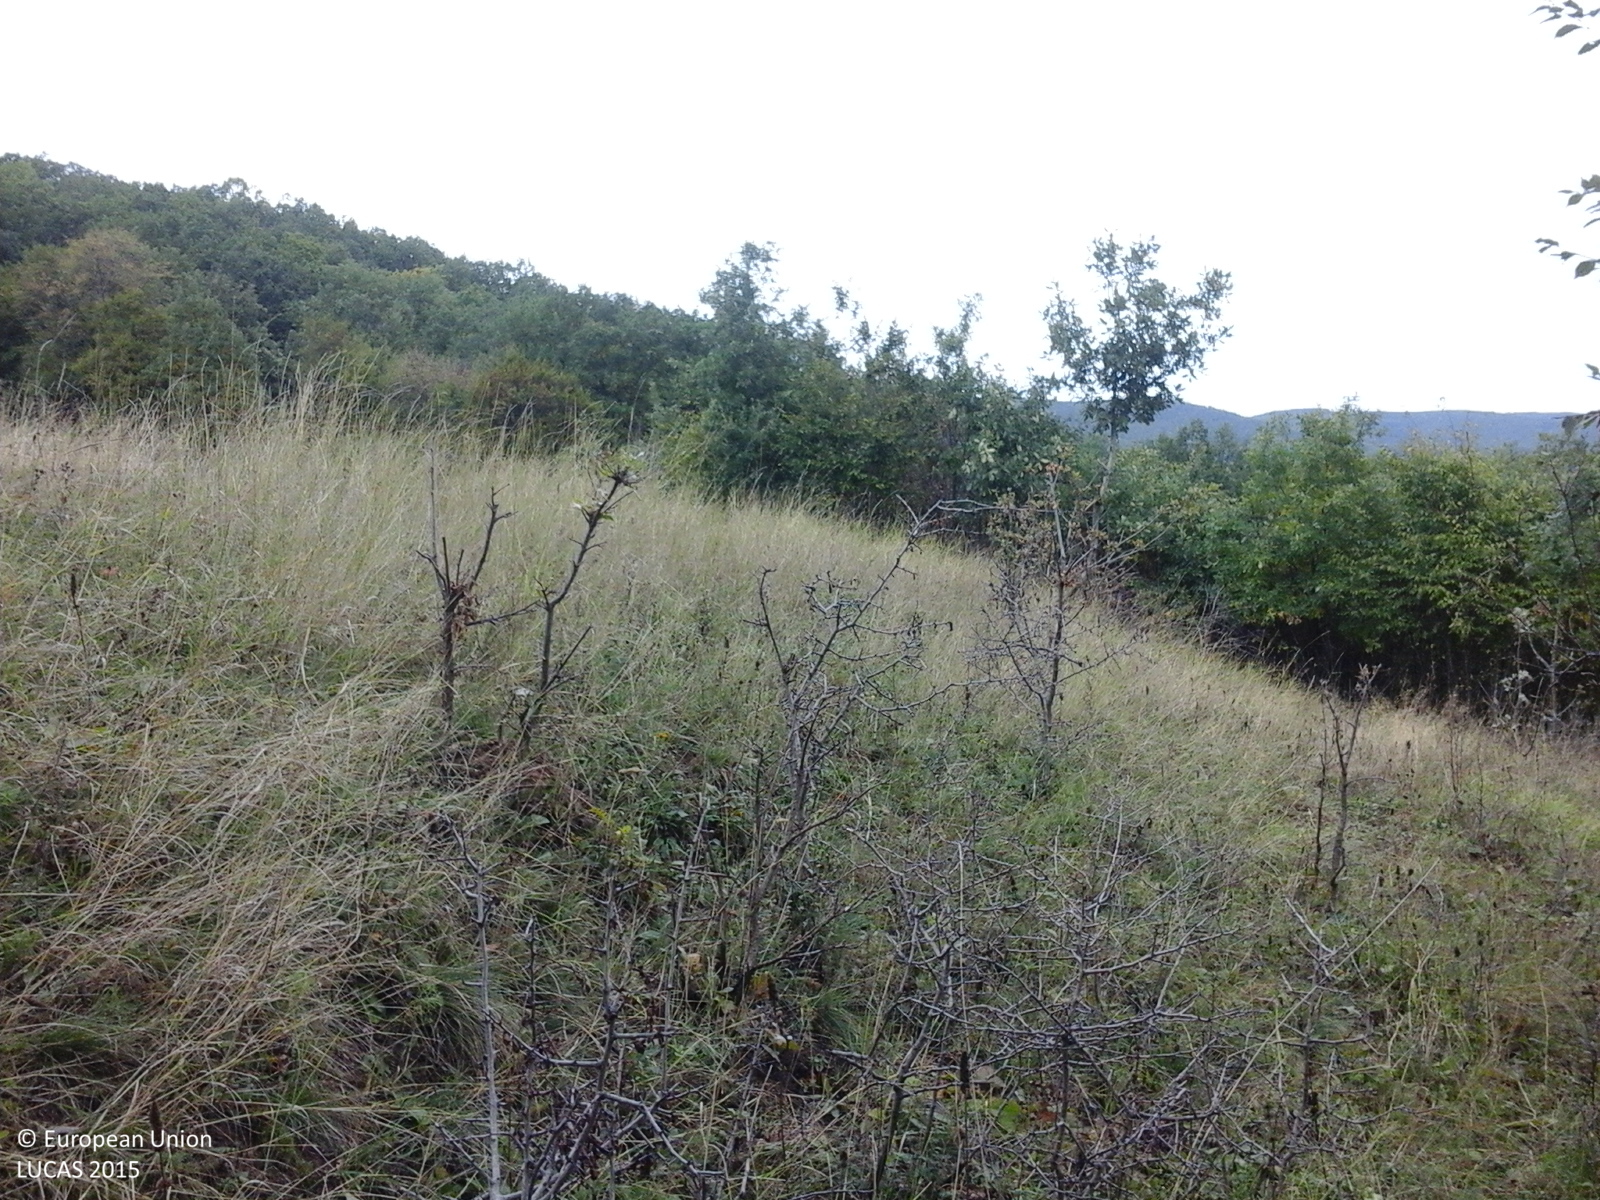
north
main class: Grassland
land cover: Grassland with sparse tree/shrub cover
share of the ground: > 75 %
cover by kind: herbaceous plants 85 %, shrubs 10 %, broadleaved forest trees 5 %
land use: Agriculture (excluding fallow land and kitchen gardens)
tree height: > 5 m
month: October
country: RO
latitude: 46.2372
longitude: 23.5140
